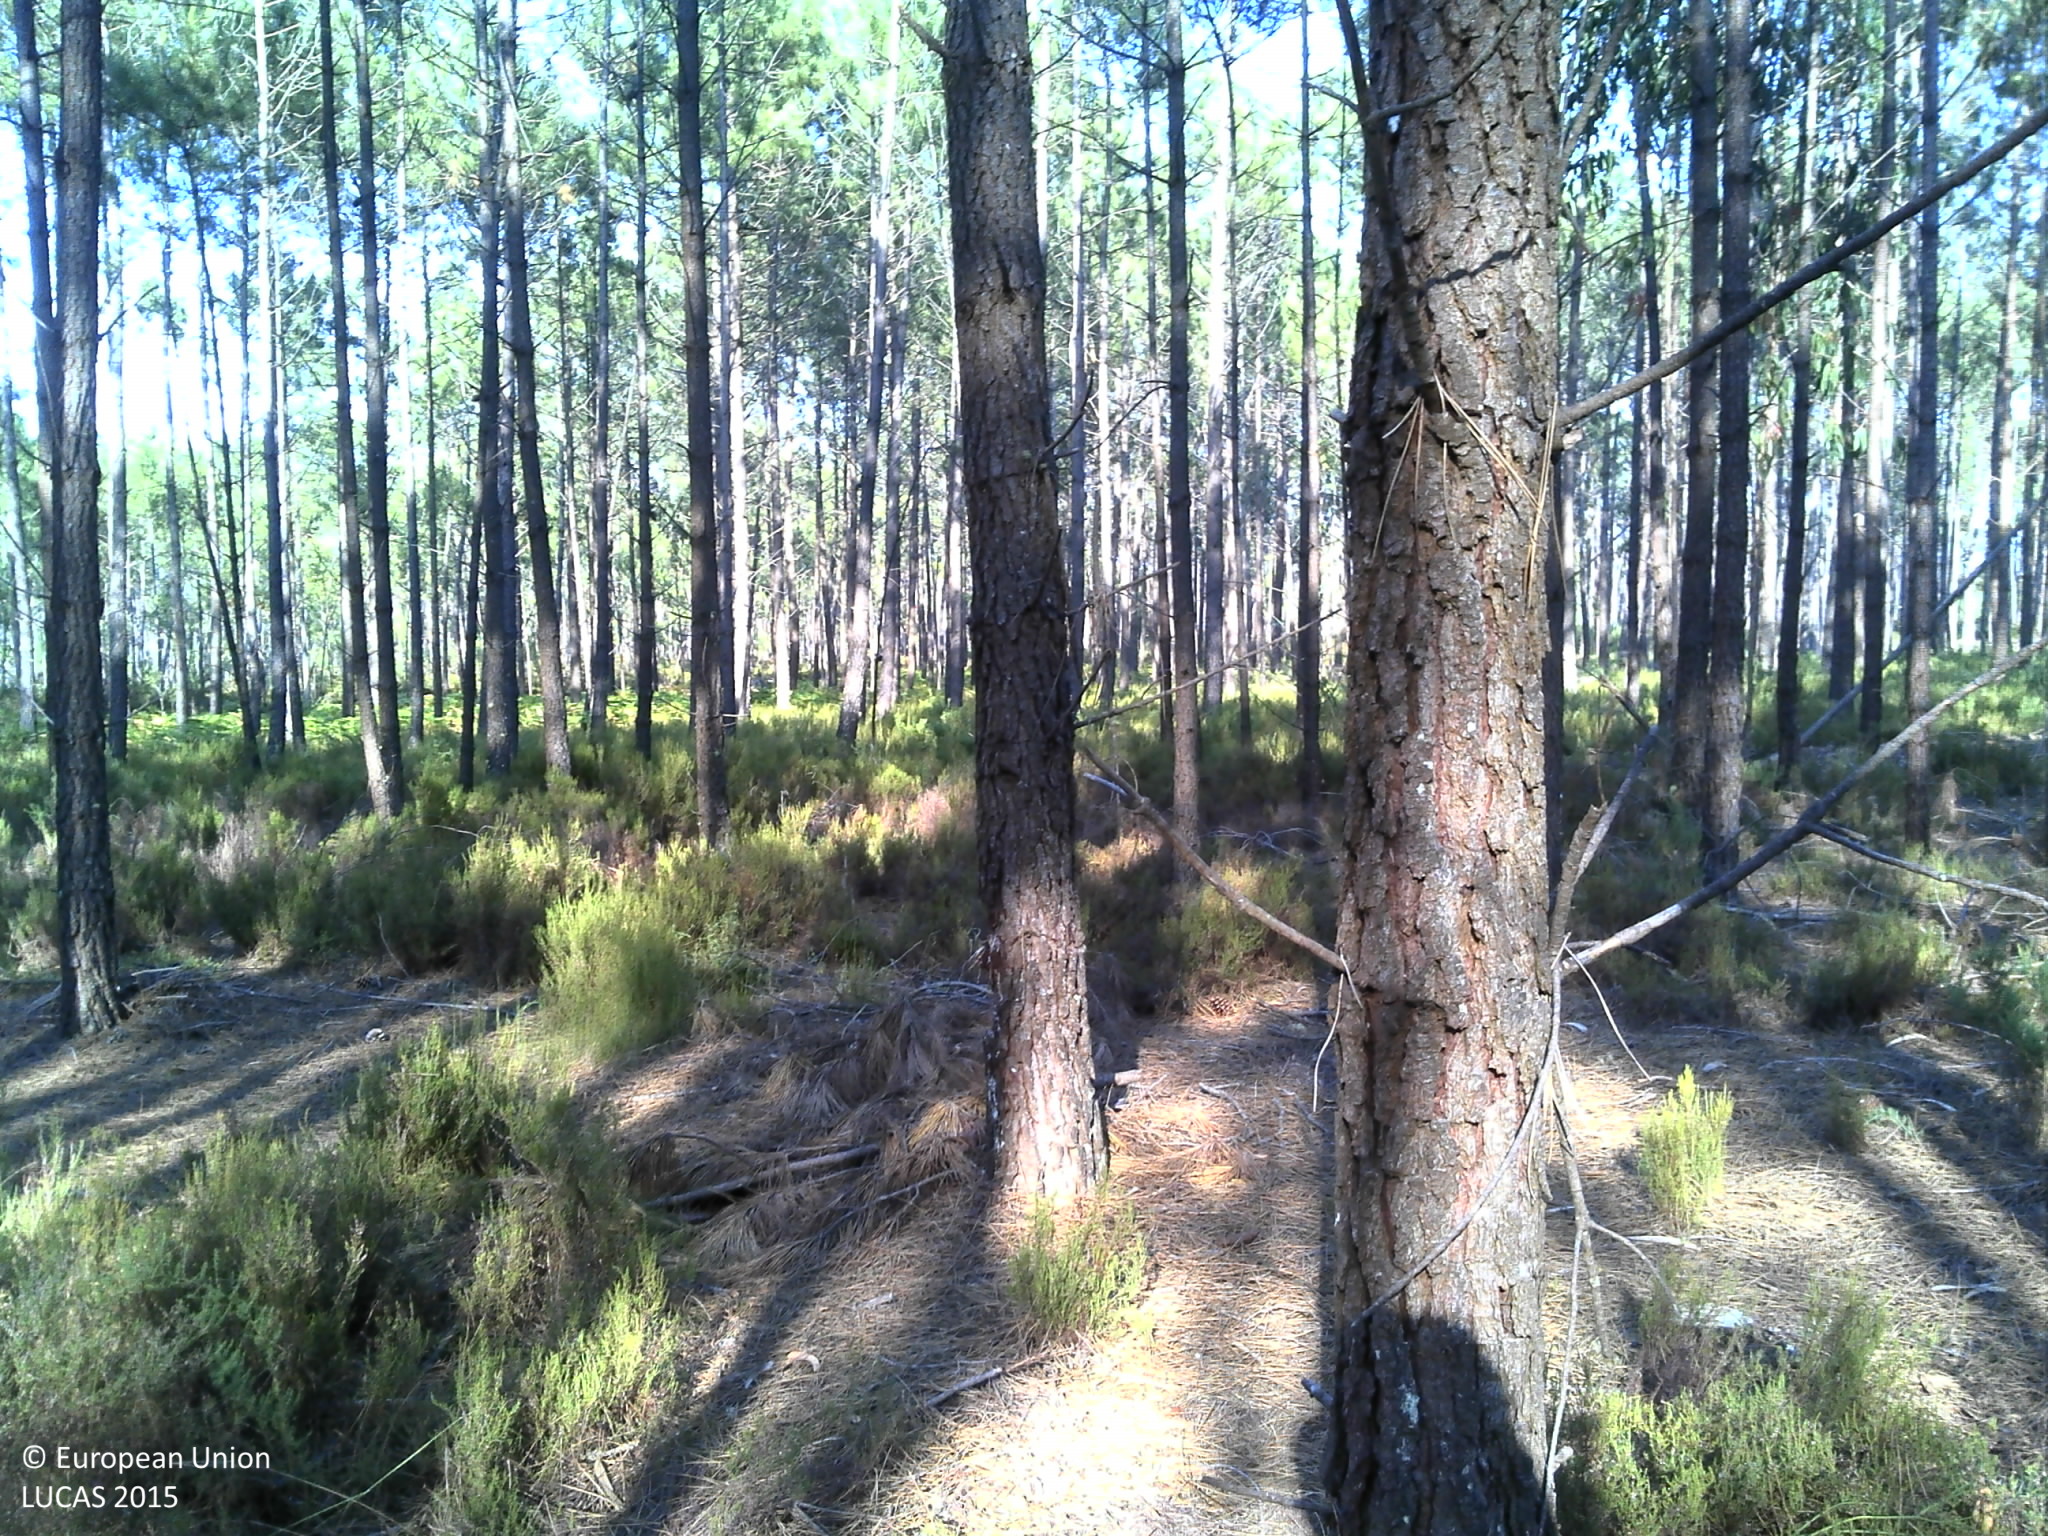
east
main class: Woodland
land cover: Pine dominated coniferous woodland
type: coniferous forest of the mediterranean region
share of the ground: > 75 %
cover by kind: coniferous forest trees 85 %, unconsolidated bare surface 10 %, shrubs 5 %
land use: Forestry
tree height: > 5 m
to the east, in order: Pine dominated coniferous woodland; Pine dominated mixed woodland; Pine dominated coniferous woodland; Tracks; Pine dominated mixed woodland; Pine dominated coniferous woodland; Broadleaved woodland; Pine dominated coniferous woodland; Broadleaved woodland
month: June
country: PT
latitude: 39.7818
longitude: -8.8996
